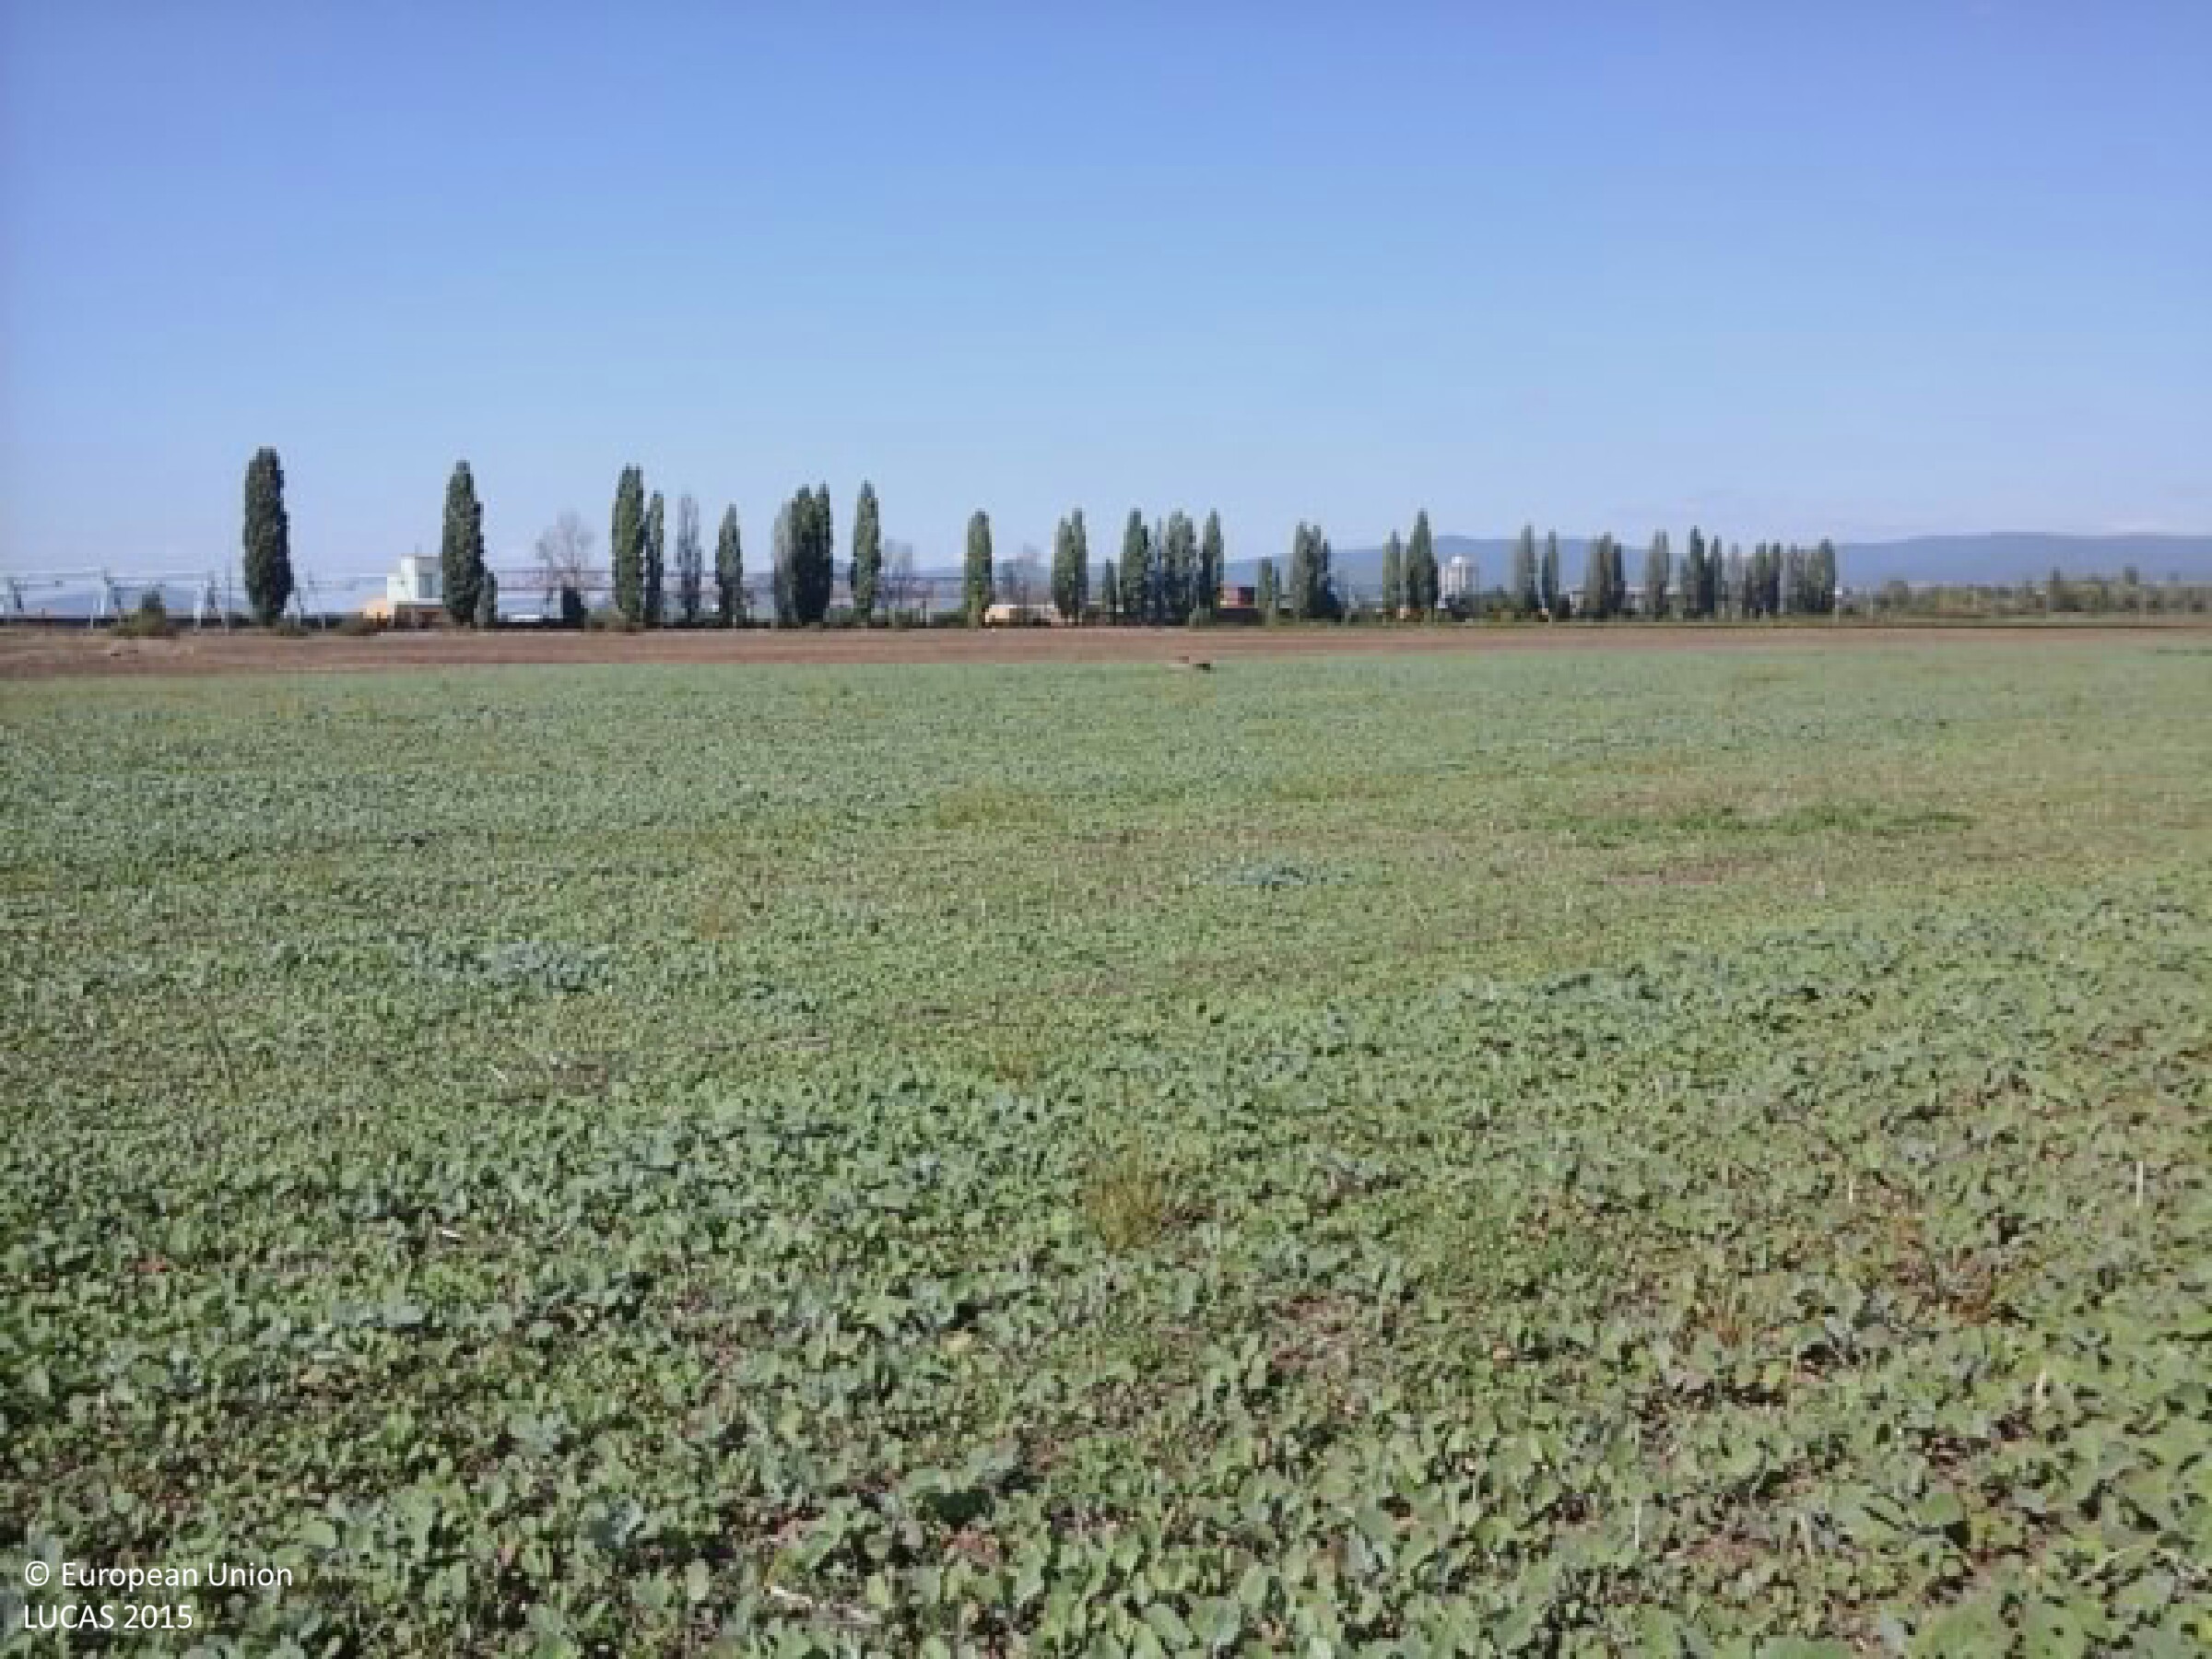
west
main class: Cropland
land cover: Rape and turnip rape
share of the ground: > 75 %
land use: Agriculture (excluding fallow land and kitchen gardens)
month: September
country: HU
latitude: 47.7553
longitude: 19.9379
